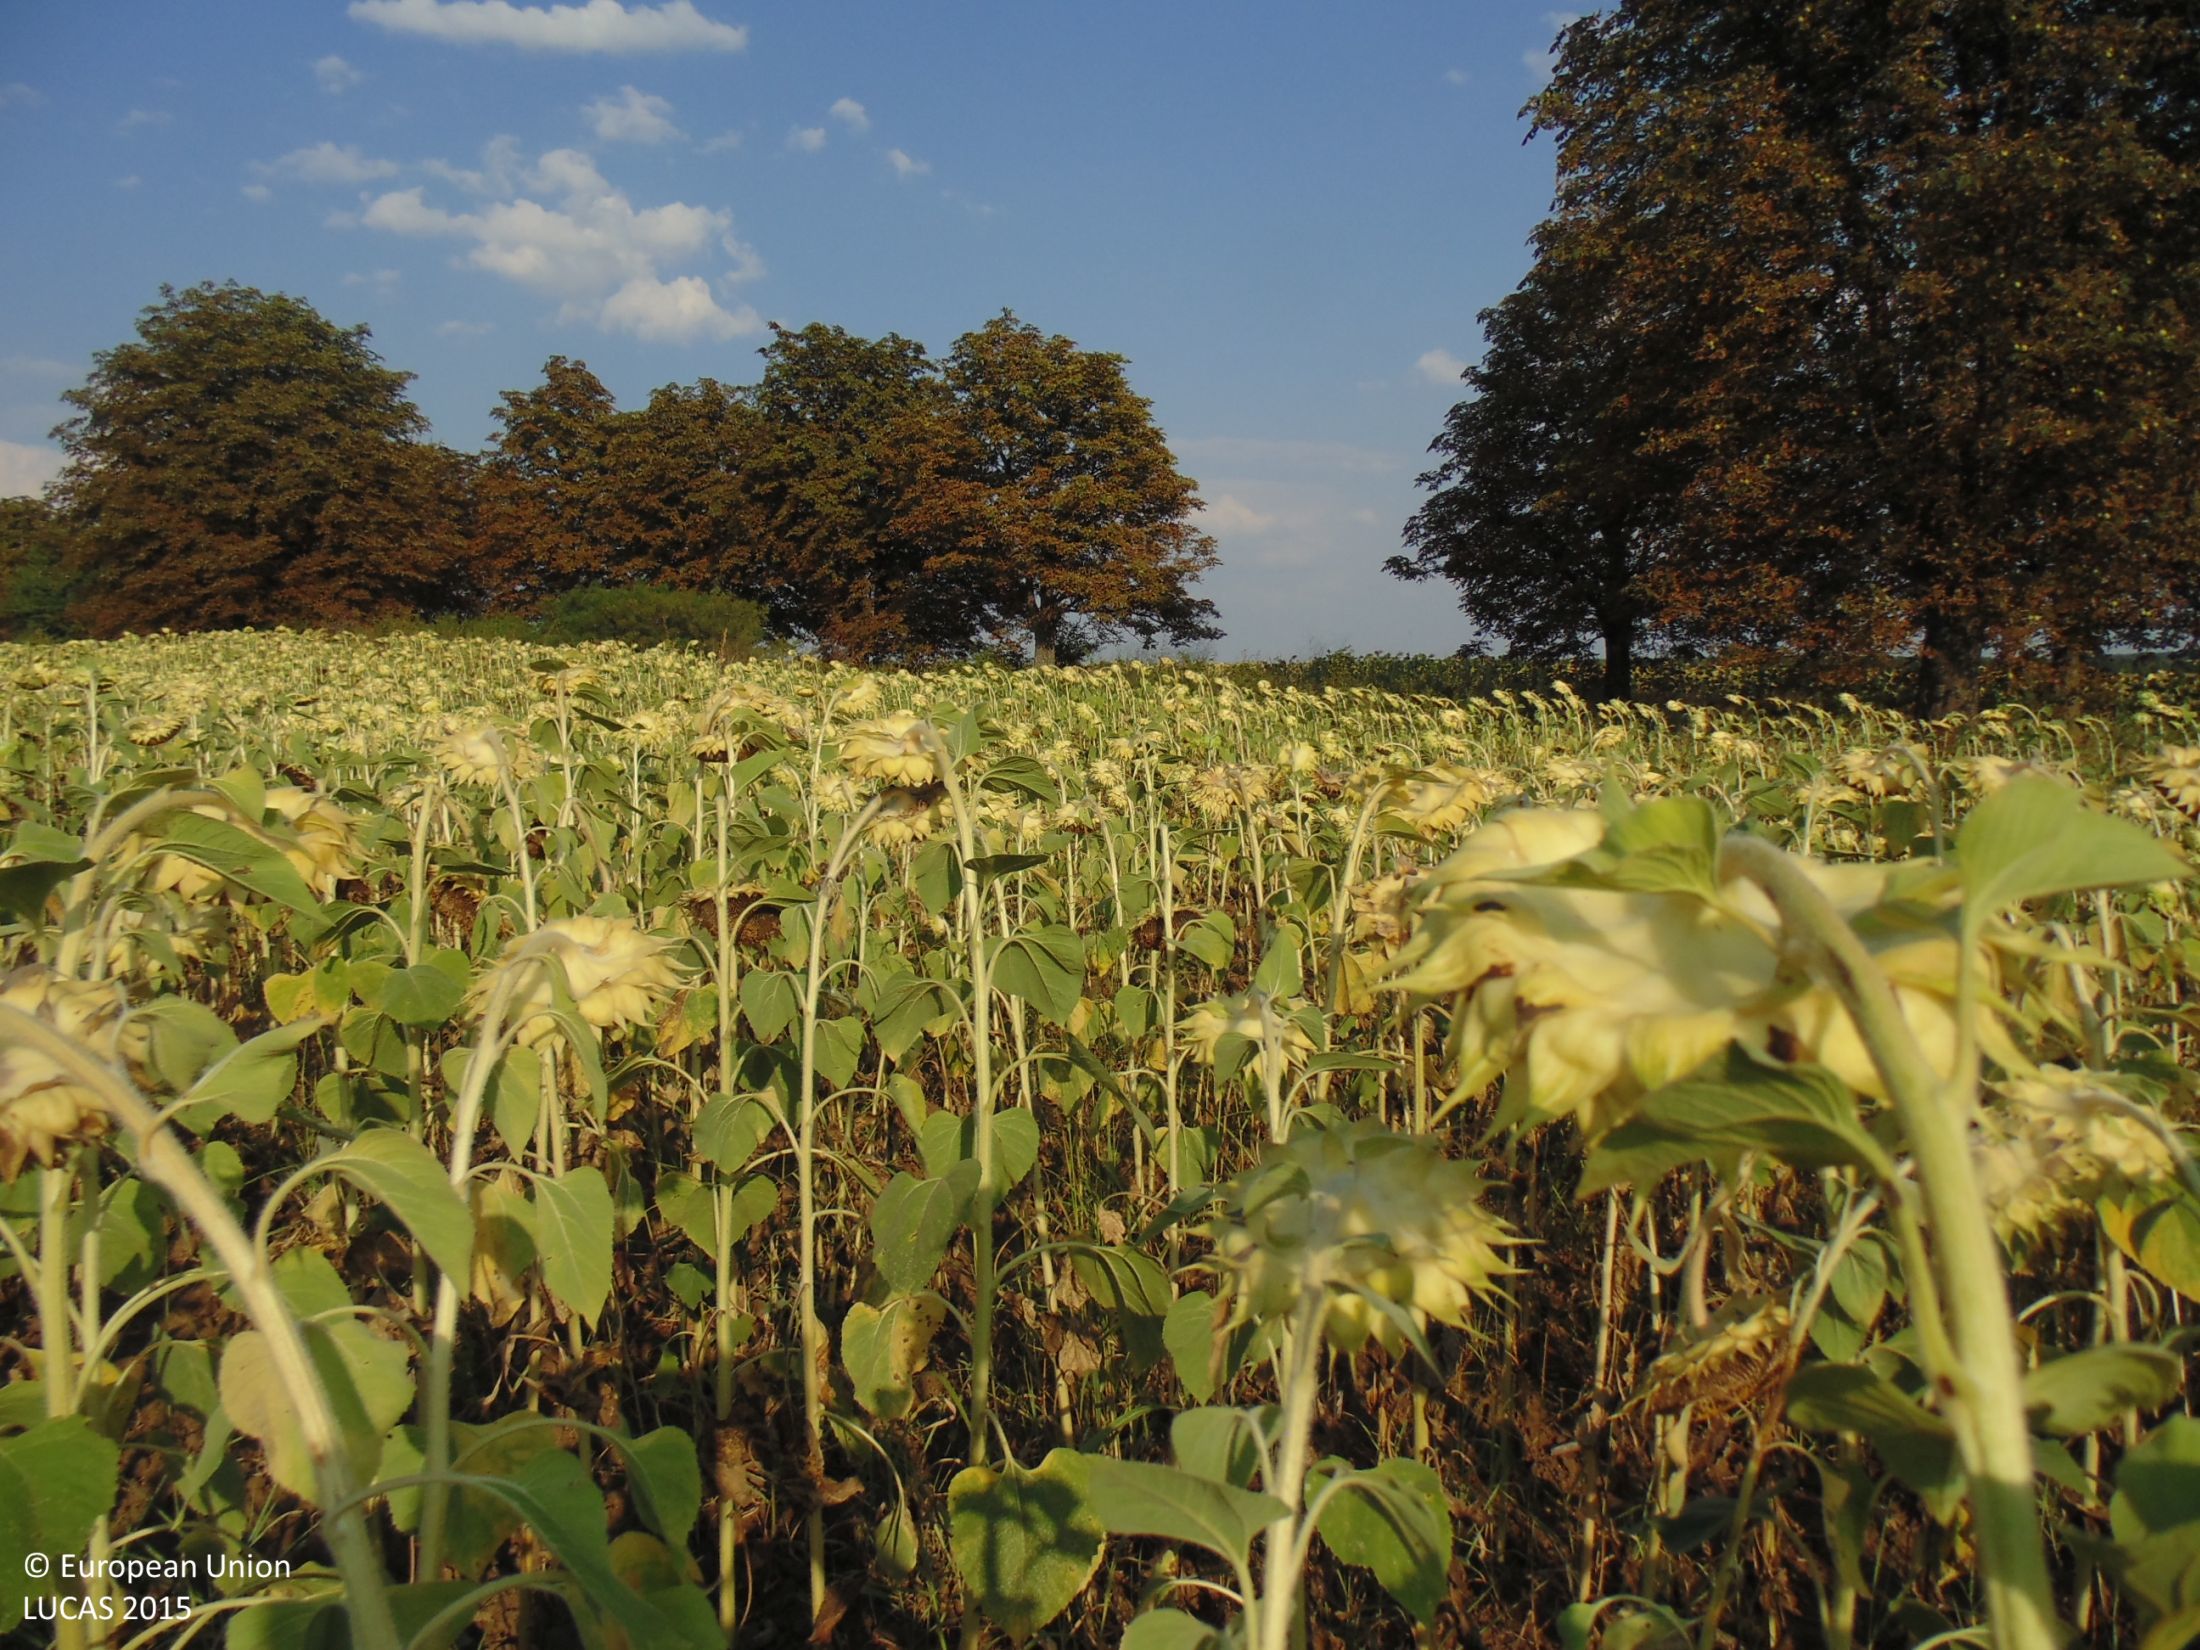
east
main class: Cropland
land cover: Sunflower
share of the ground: > 75 %
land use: Agriculture (excluding fallow land and kitchen gardens)
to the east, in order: Sunflower; Electric lines; Sunflower; Grassland with sparse tree/shrub cover
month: August
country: BG
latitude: 43.8813
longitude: 27.4979
